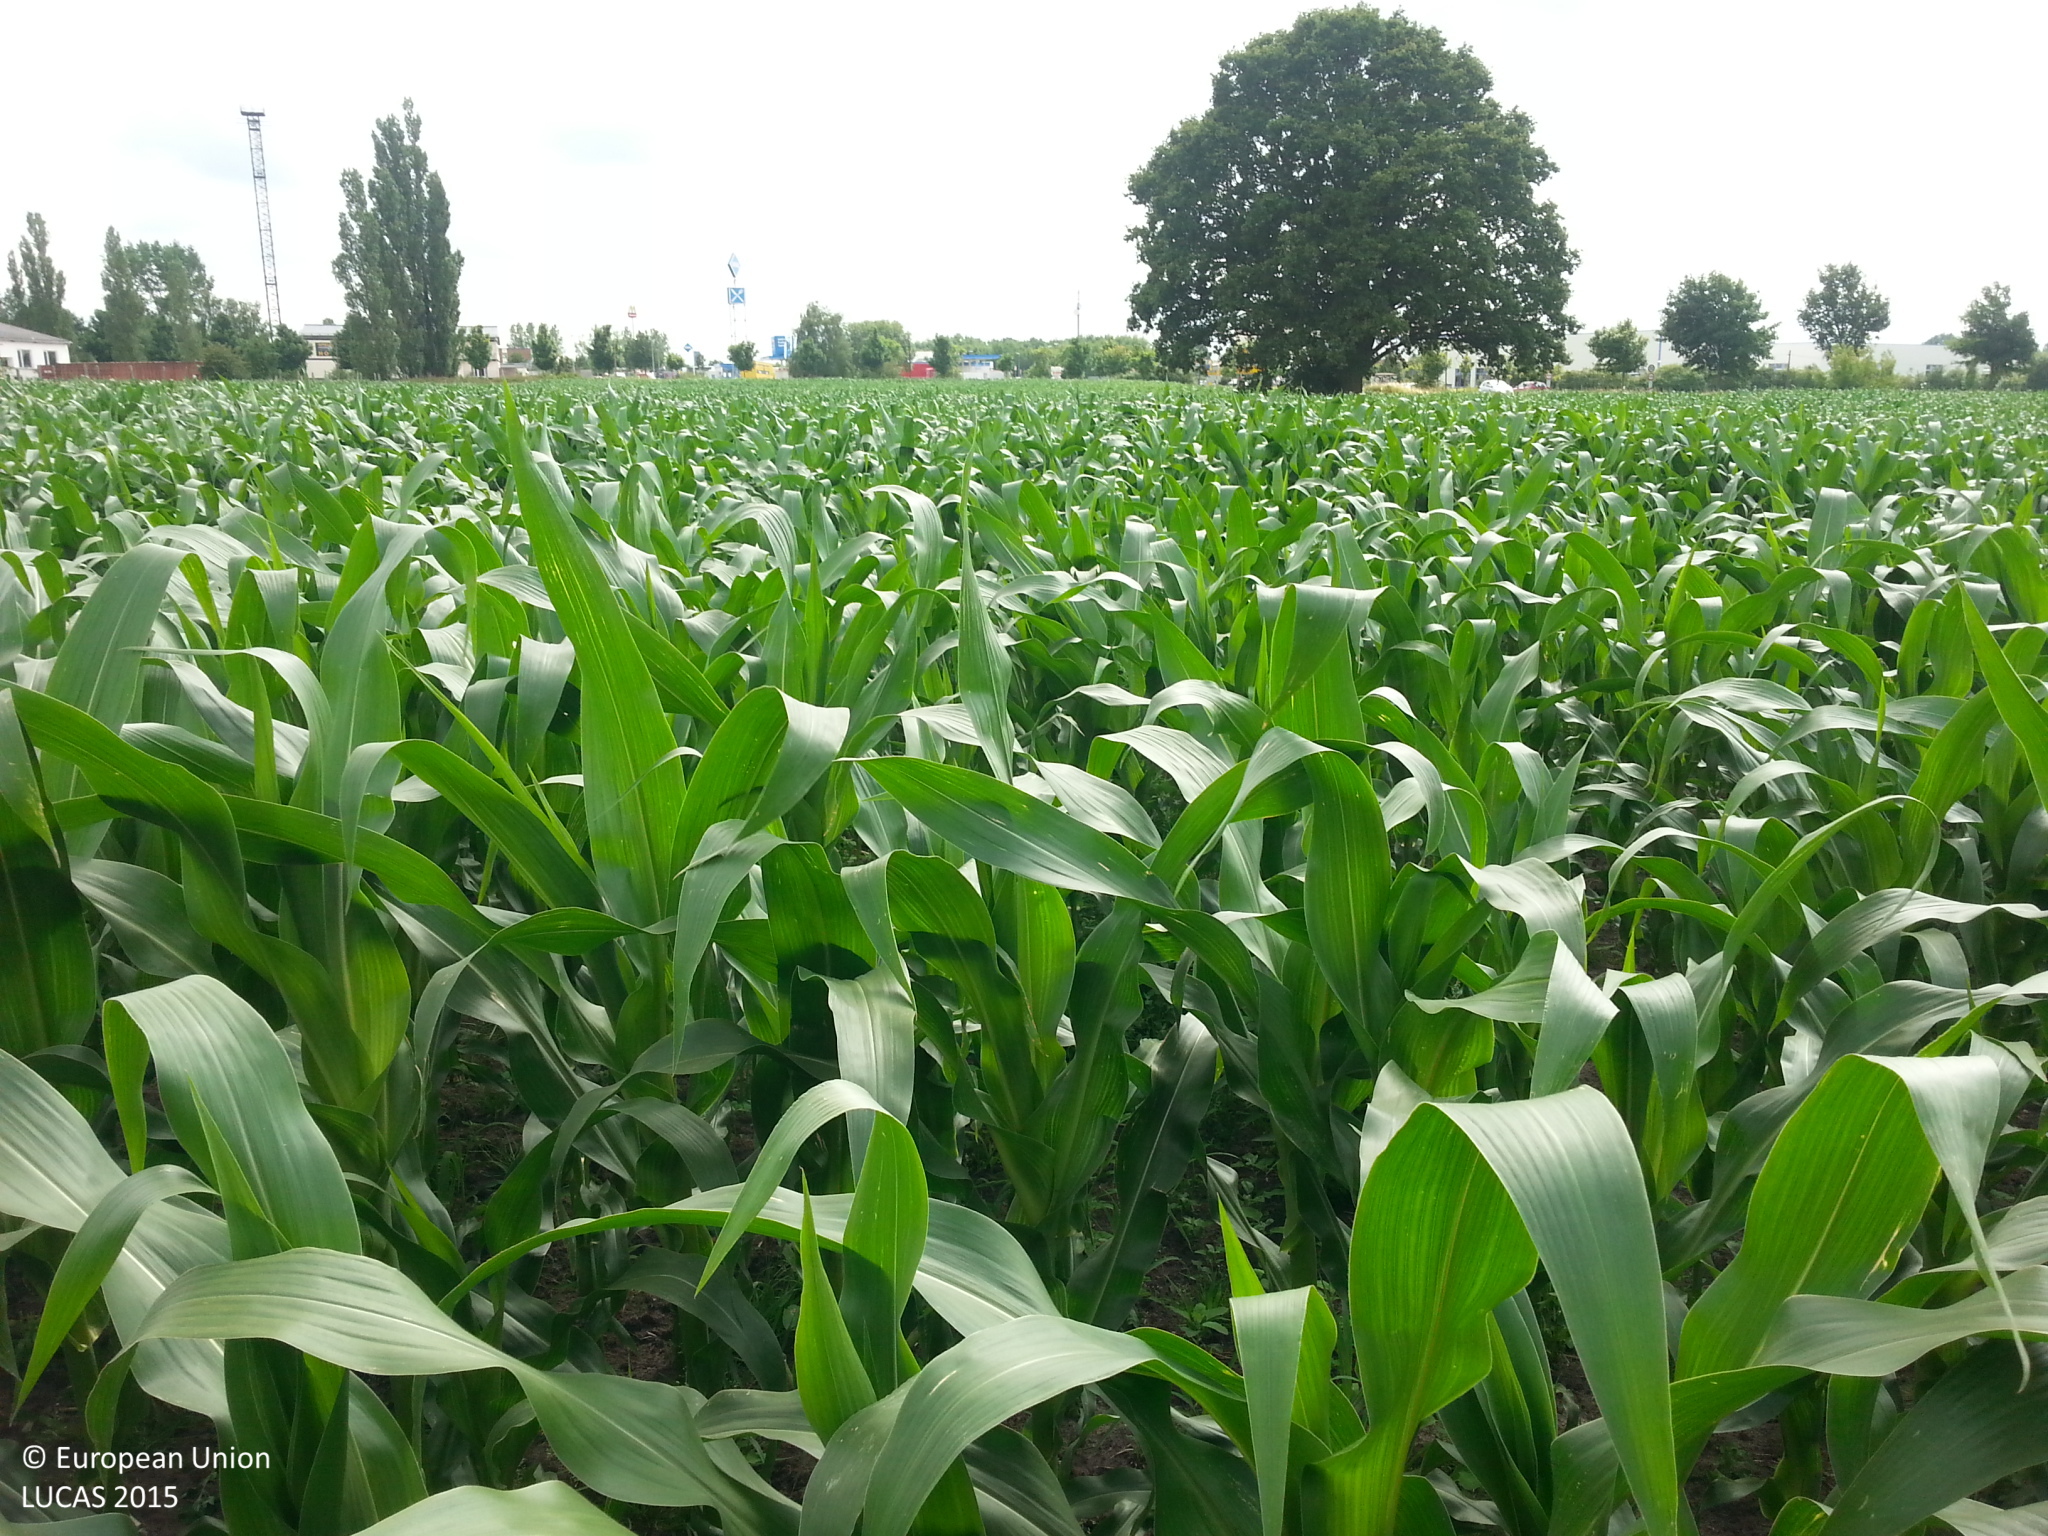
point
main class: Cropland
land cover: Maize
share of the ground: > 75 %
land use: Agriculture (excluding fallow land and kitchen gardens)
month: July
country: DE
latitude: 53.5048
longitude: 11.1001
